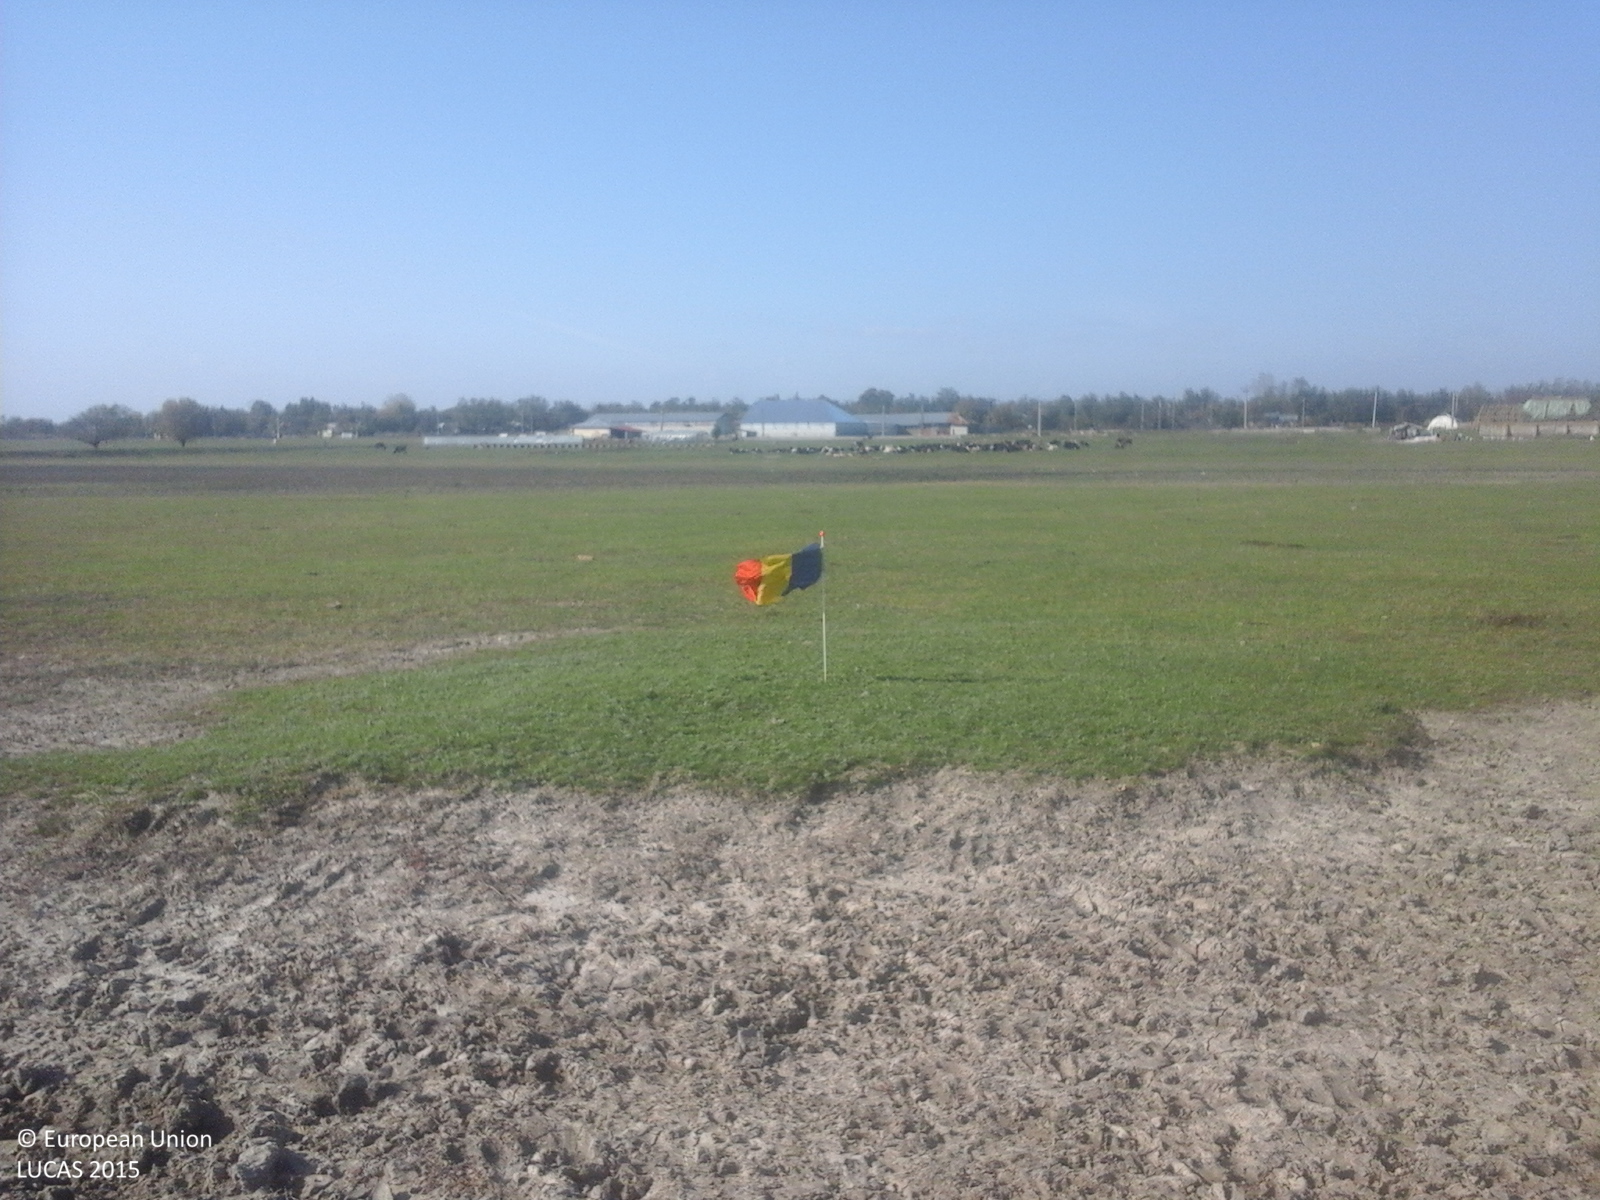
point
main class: Grassland
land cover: Grassland without tree/shrub cover
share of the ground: > 75 %
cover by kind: herbaceous plants 100 %
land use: Agriculture (excluding fallow land and kitchen gardens)
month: October
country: RO
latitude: 45.2839
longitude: 27.3714
